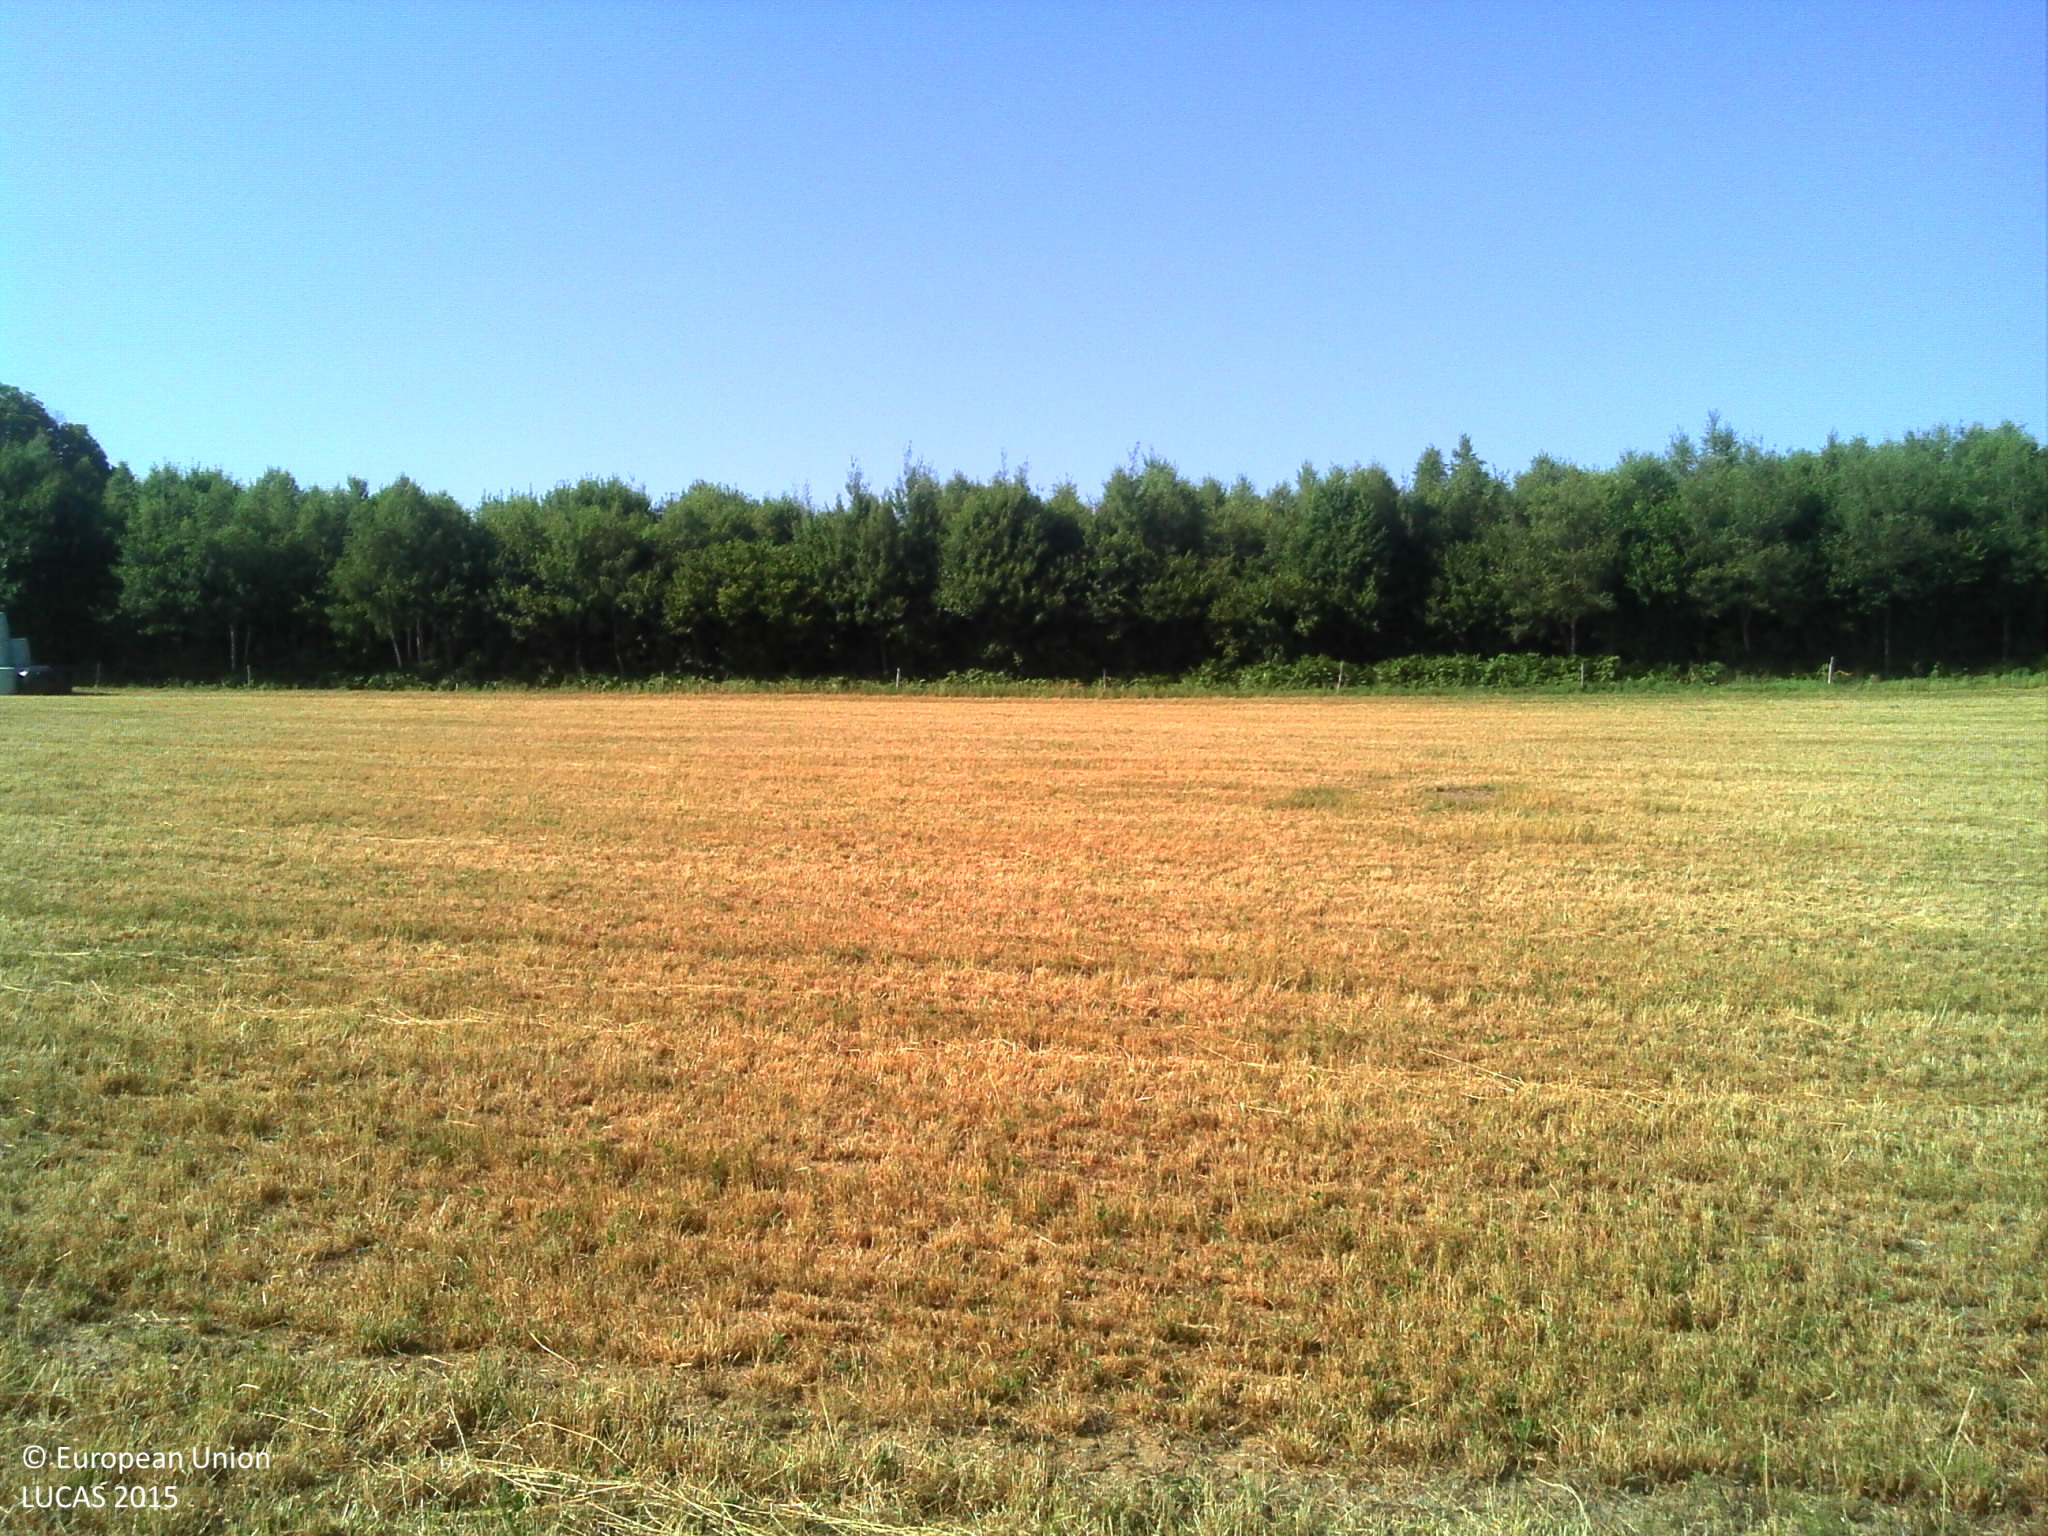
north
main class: Grassland
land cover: Grassland without tree/shrub cover
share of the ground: > 75 %
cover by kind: herbaceous plants 100 %
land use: Agriculture (excluding fallow land and kitchen gardens)
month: July
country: FR
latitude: 46.1226
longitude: 1.7491
